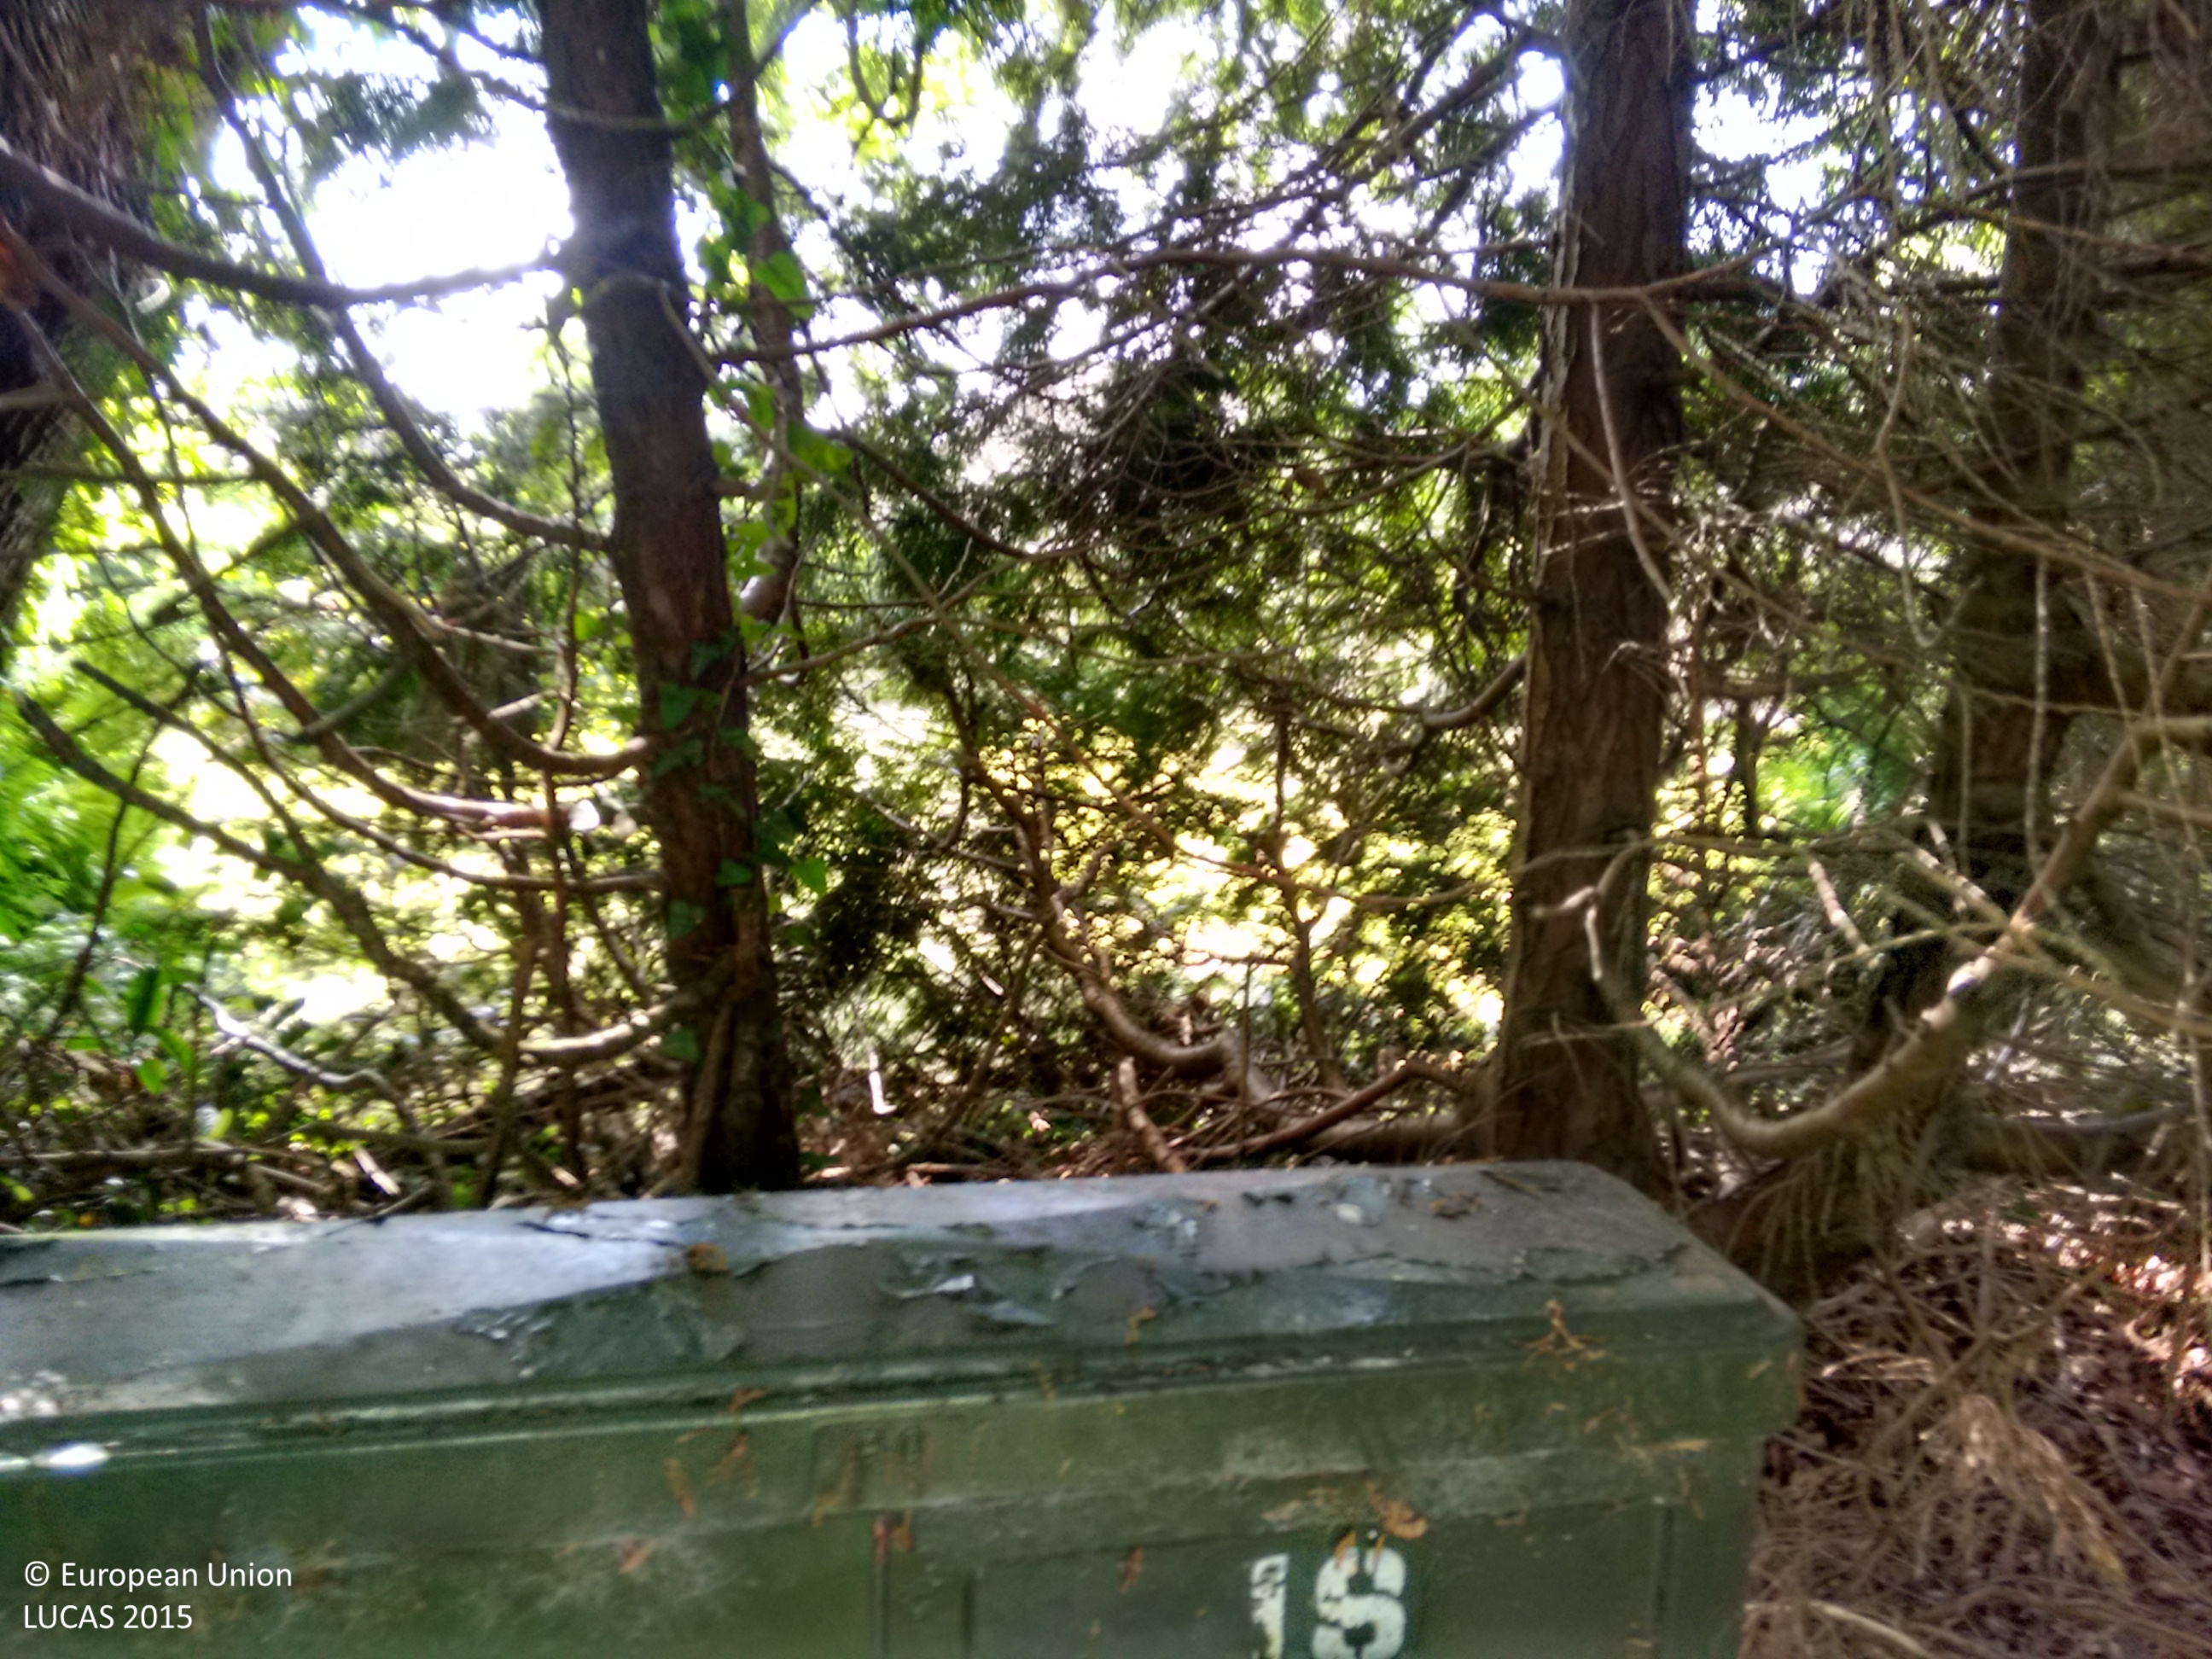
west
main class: Woodland
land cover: Broadleaved woodland
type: mesophytic deciduous forest
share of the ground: > 75 %
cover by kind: broadleaved forest trees 100 %
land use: Semi-natural and natural areas not in use
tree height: > 5 m
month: May
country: GB
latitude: 50.9493
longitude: -1.4519
